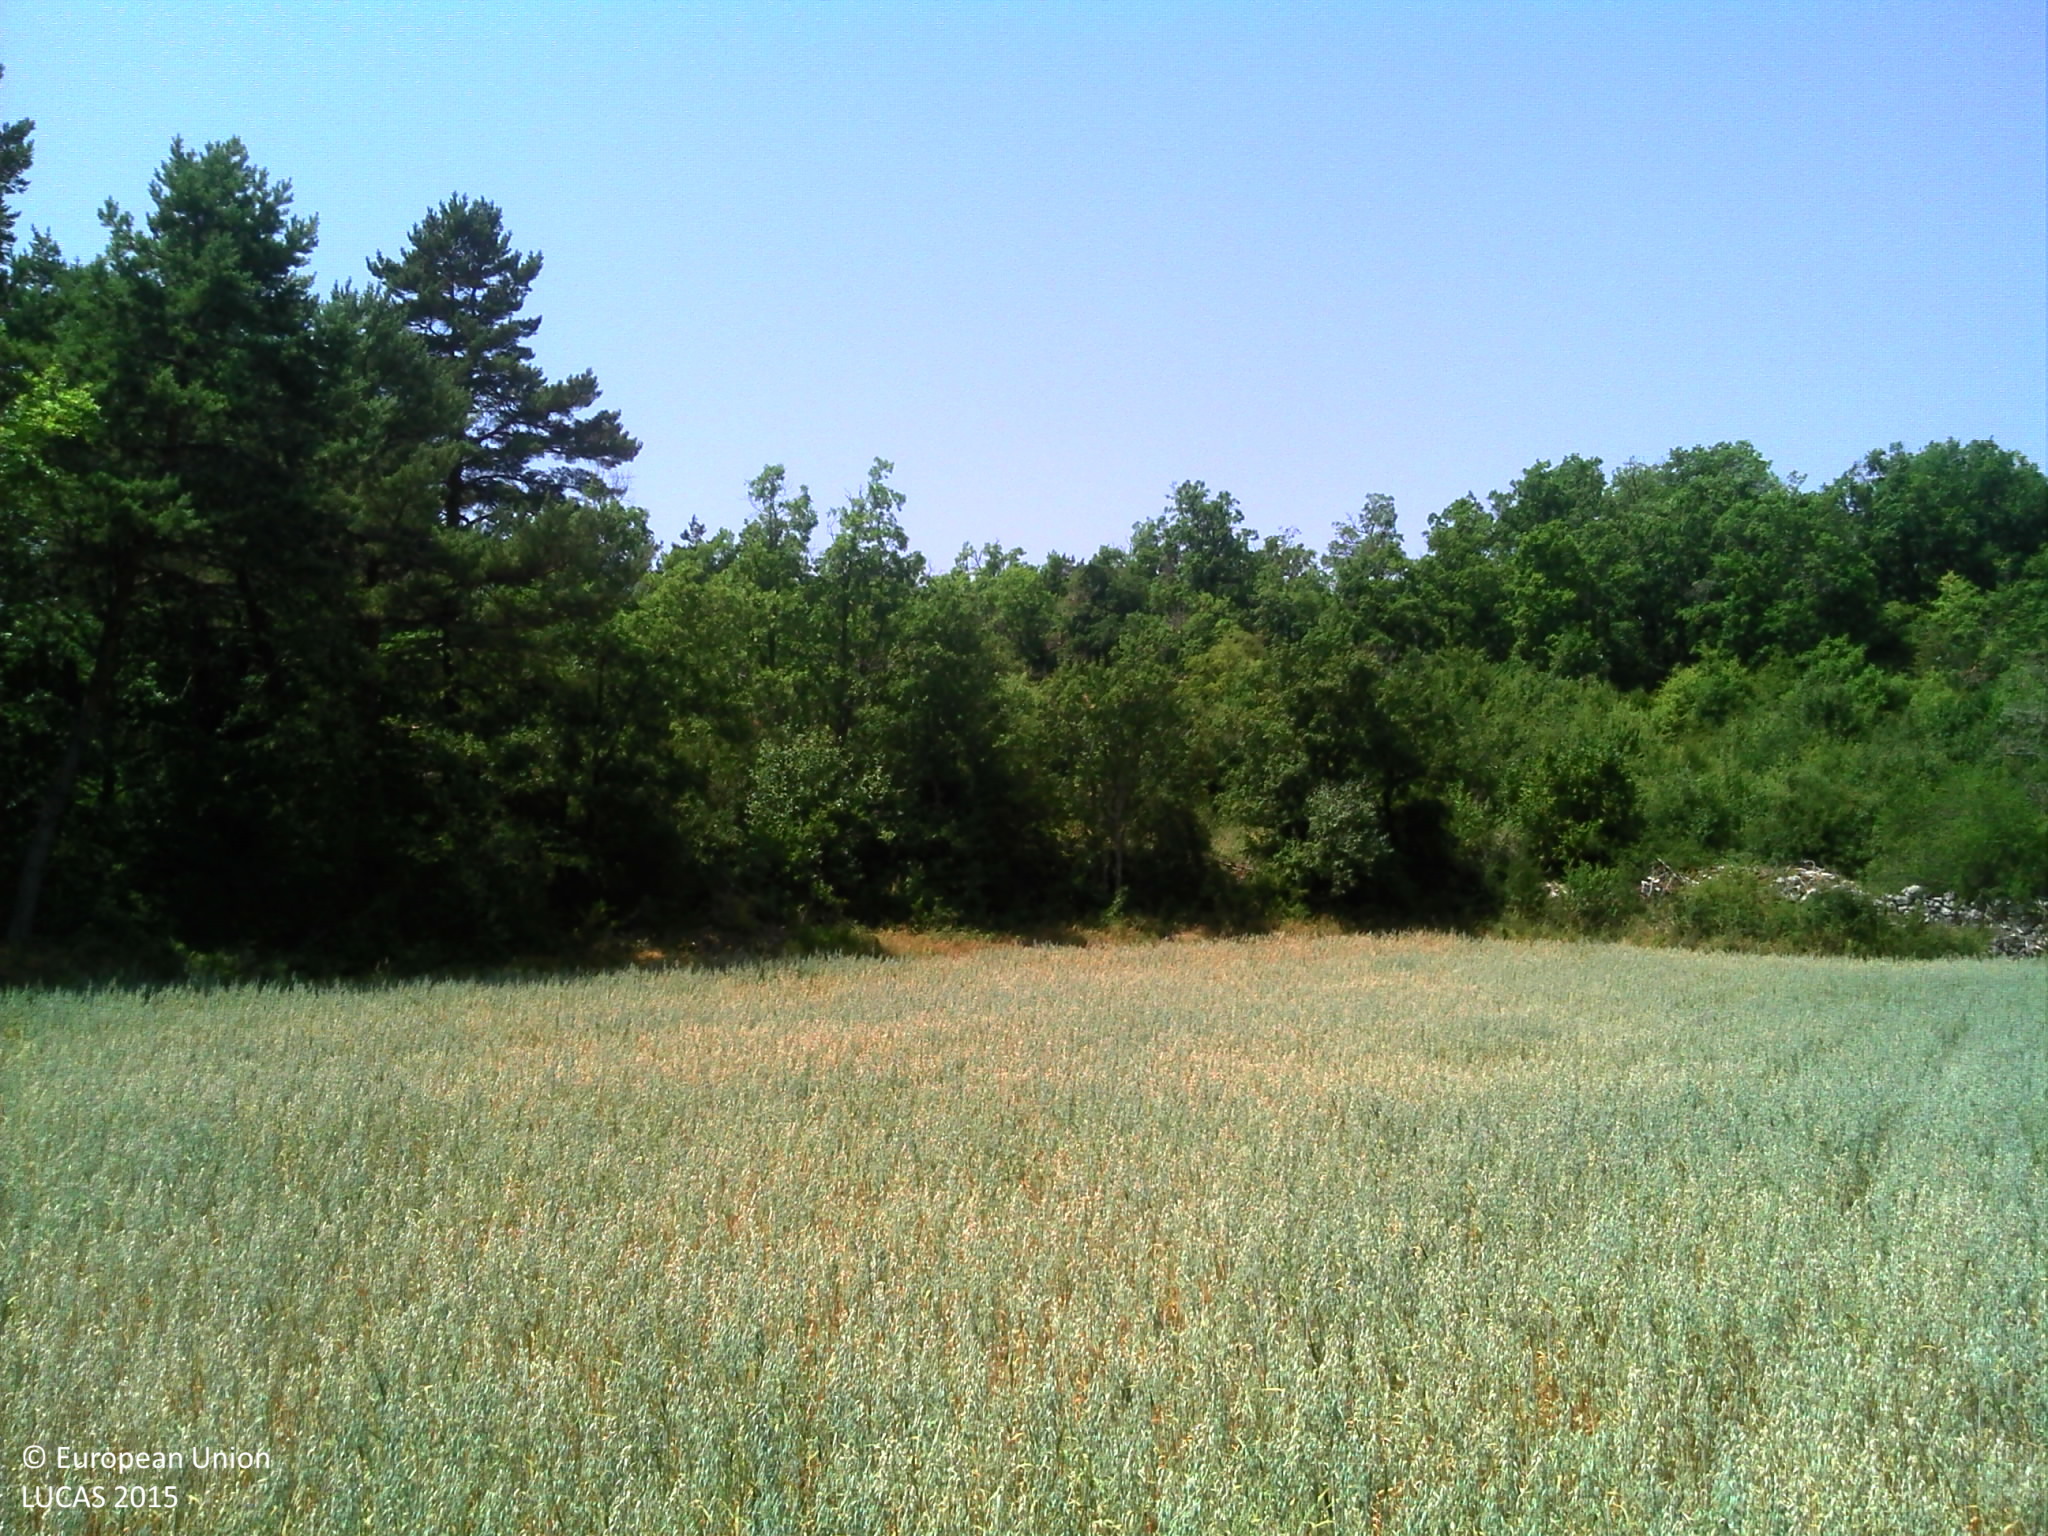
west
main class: Cropland
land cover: Oats
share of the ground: > 75 %
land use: Agriculture (excluding fallow land and kitchen gardens)
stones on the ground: 25 - 50 %
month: July
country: FR
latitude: 44.3131
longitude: 3.2731
